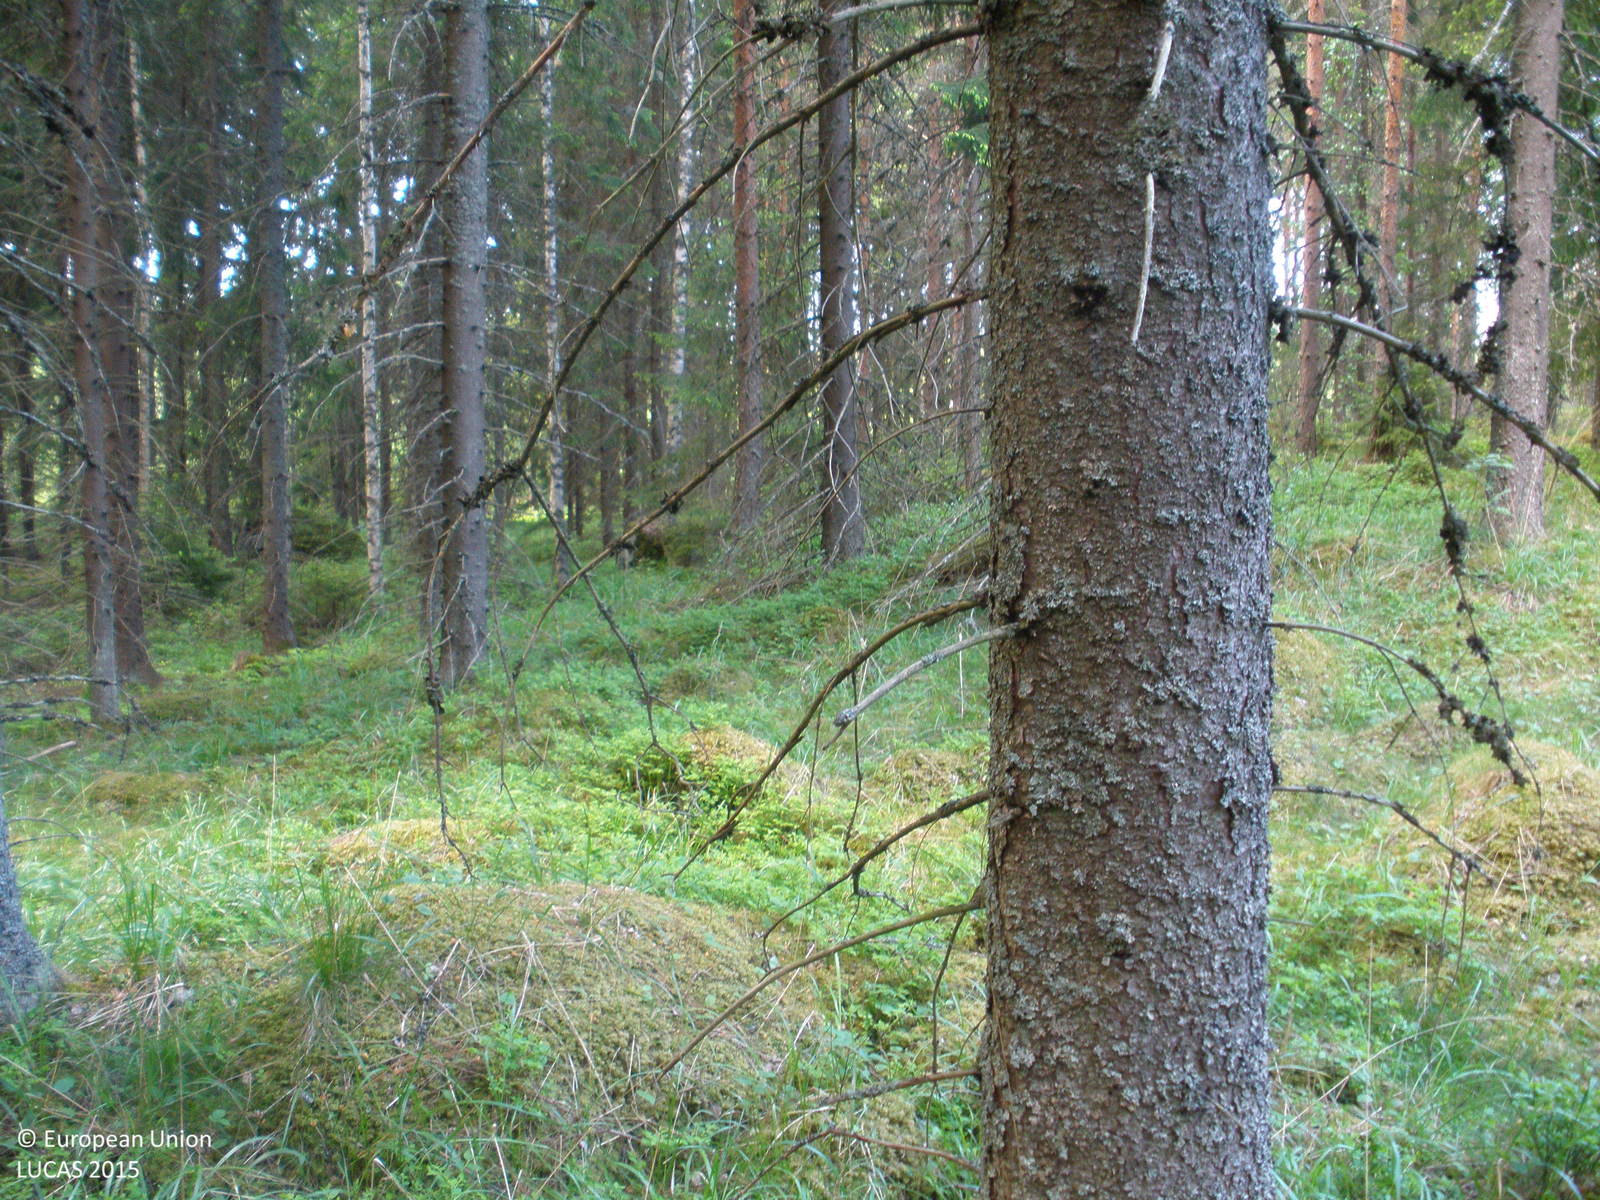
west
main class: Woodland
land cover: Spruce dominated mixed woodland
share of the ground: > 75 %
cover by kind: coniferous forest trees 70 %, broadleaved forest trees 25 %, shrubs 5 %
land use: Forestry
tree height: > 5 m
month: June
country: FI
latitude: 60.5674
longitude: 23.3465
